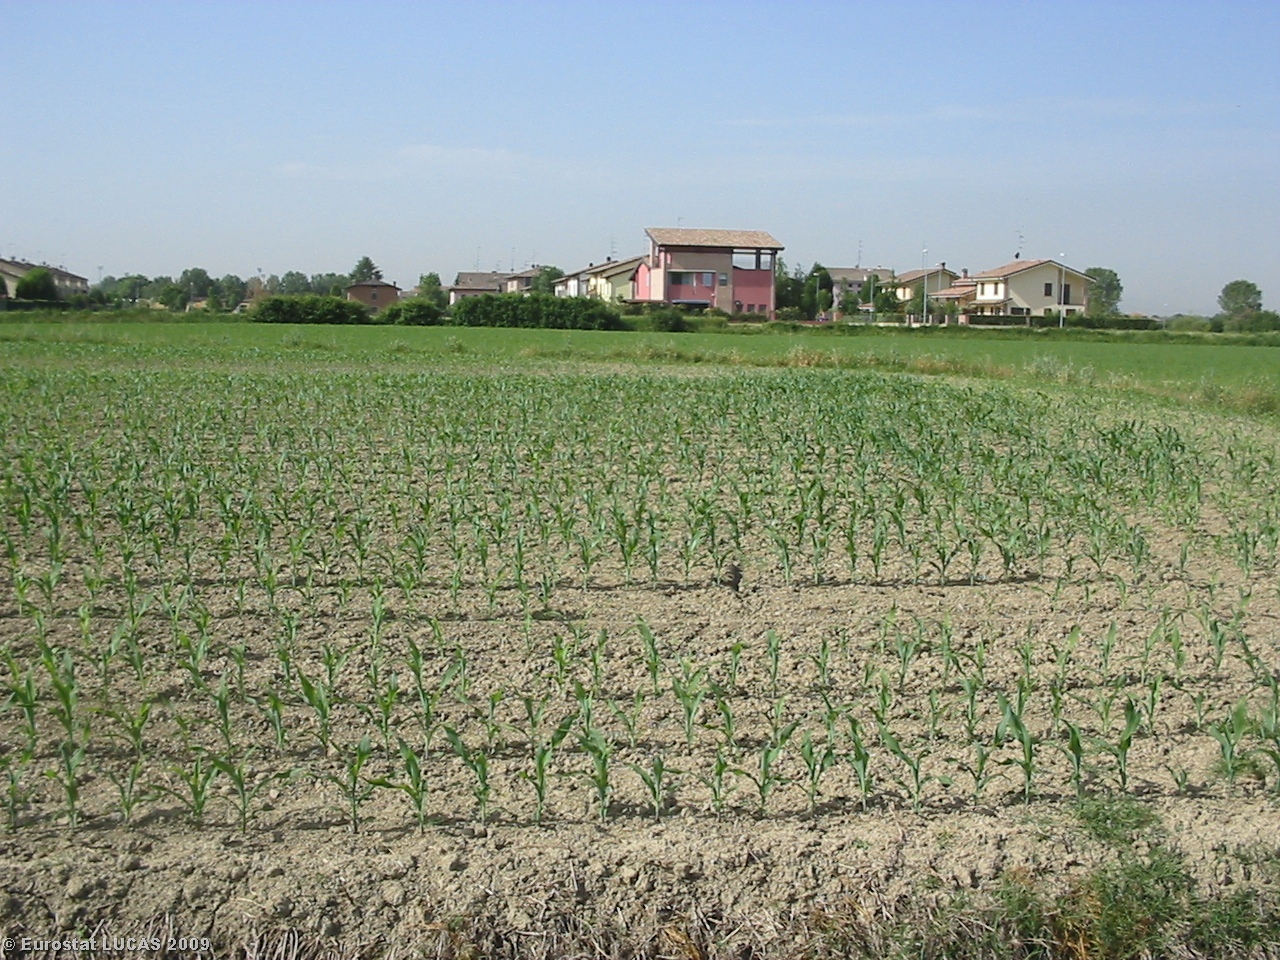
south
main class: Cropland
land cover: Common wheat
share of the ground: > 75 %
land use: Agriculture (excluding fallow land and kitchen gardens)
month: May
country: IT
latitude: 44.8545
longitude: 10.4420
